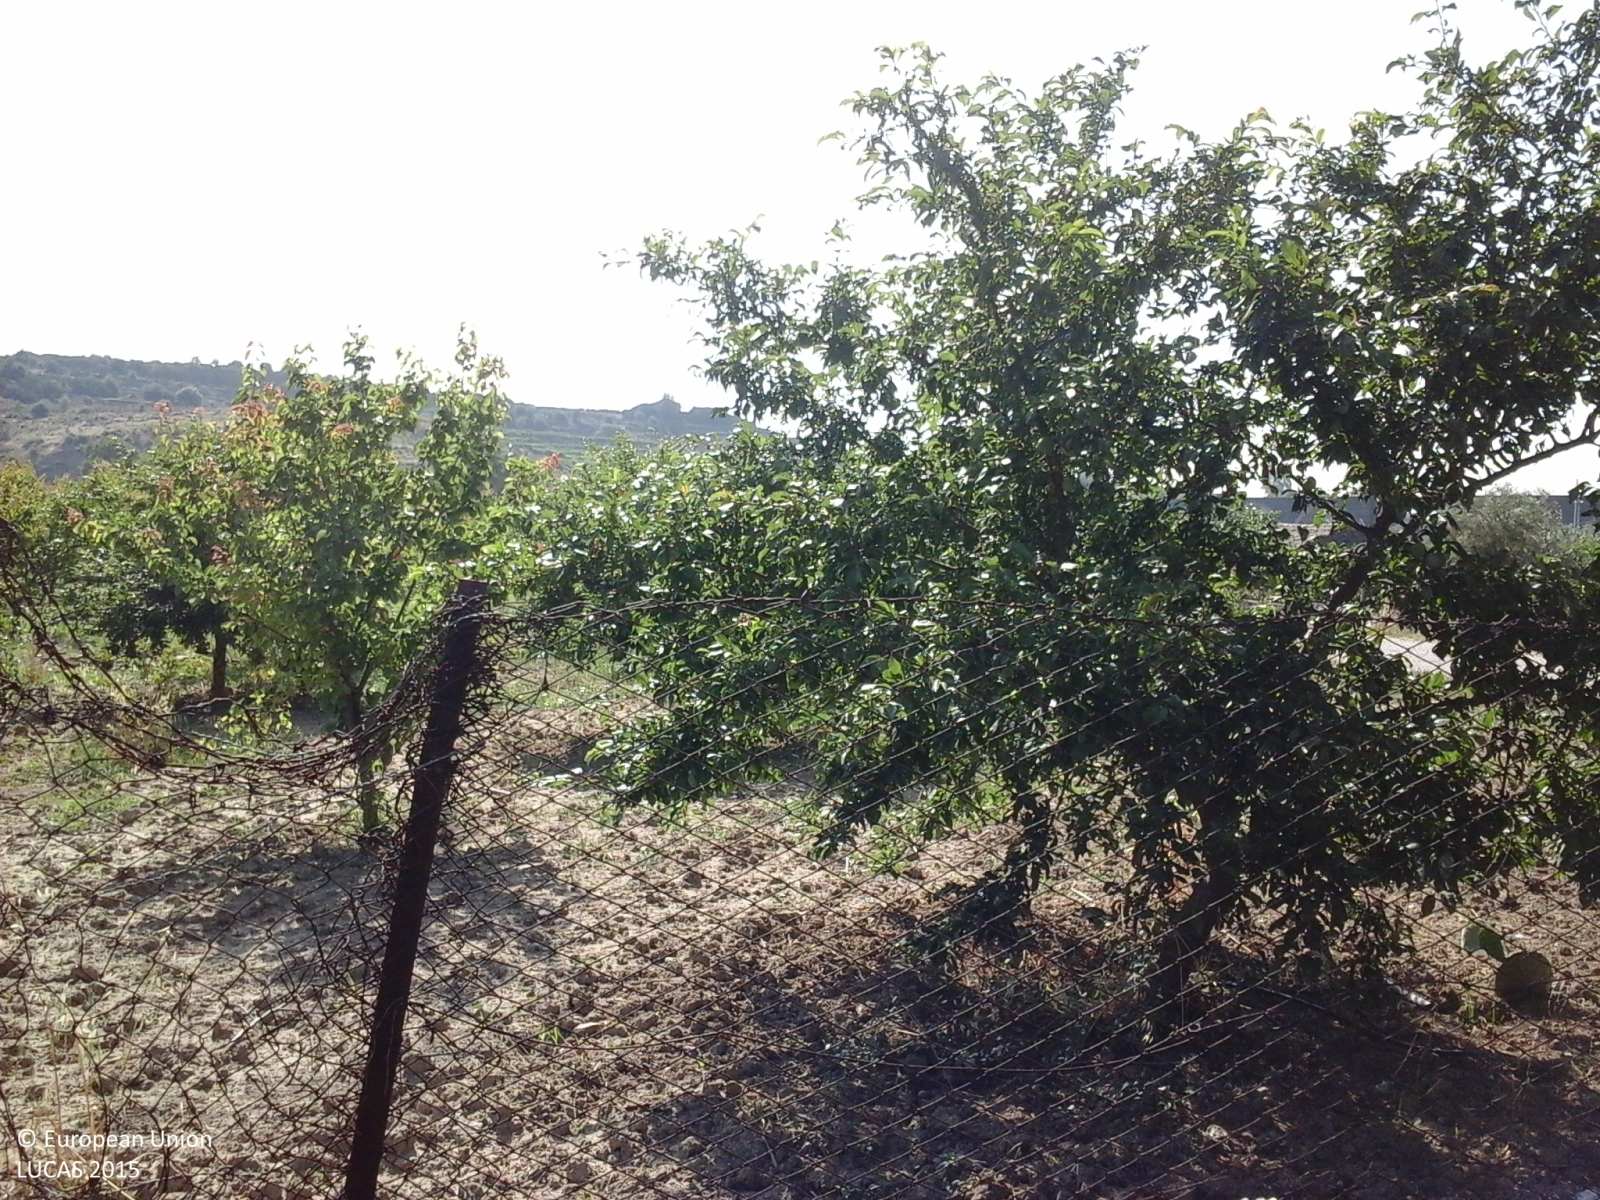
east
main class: Cropland
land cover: Oranges
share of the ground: > 75 %
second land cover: Spontaneously vegetated surfaces
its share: > 75 %
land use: Agriculture (excluding fallow land and kitchen gardens)
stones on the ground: 10 - 25 %
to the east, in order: Oranges; Spontaneously vegetated surfaces; Grass margins; Tracks; Grass margins; Oranges; Other fruit trees and berries; Shrubland with sparse tree cover; Broadleaved woodland; Spontaneously vegetated surfaces; Shrubland without tree cover; Spontaneously vegetated surfaces; Tracks; Spontaneously vegetated surfaces
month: June
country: IT
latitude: 37.6069
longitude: 14.8251
